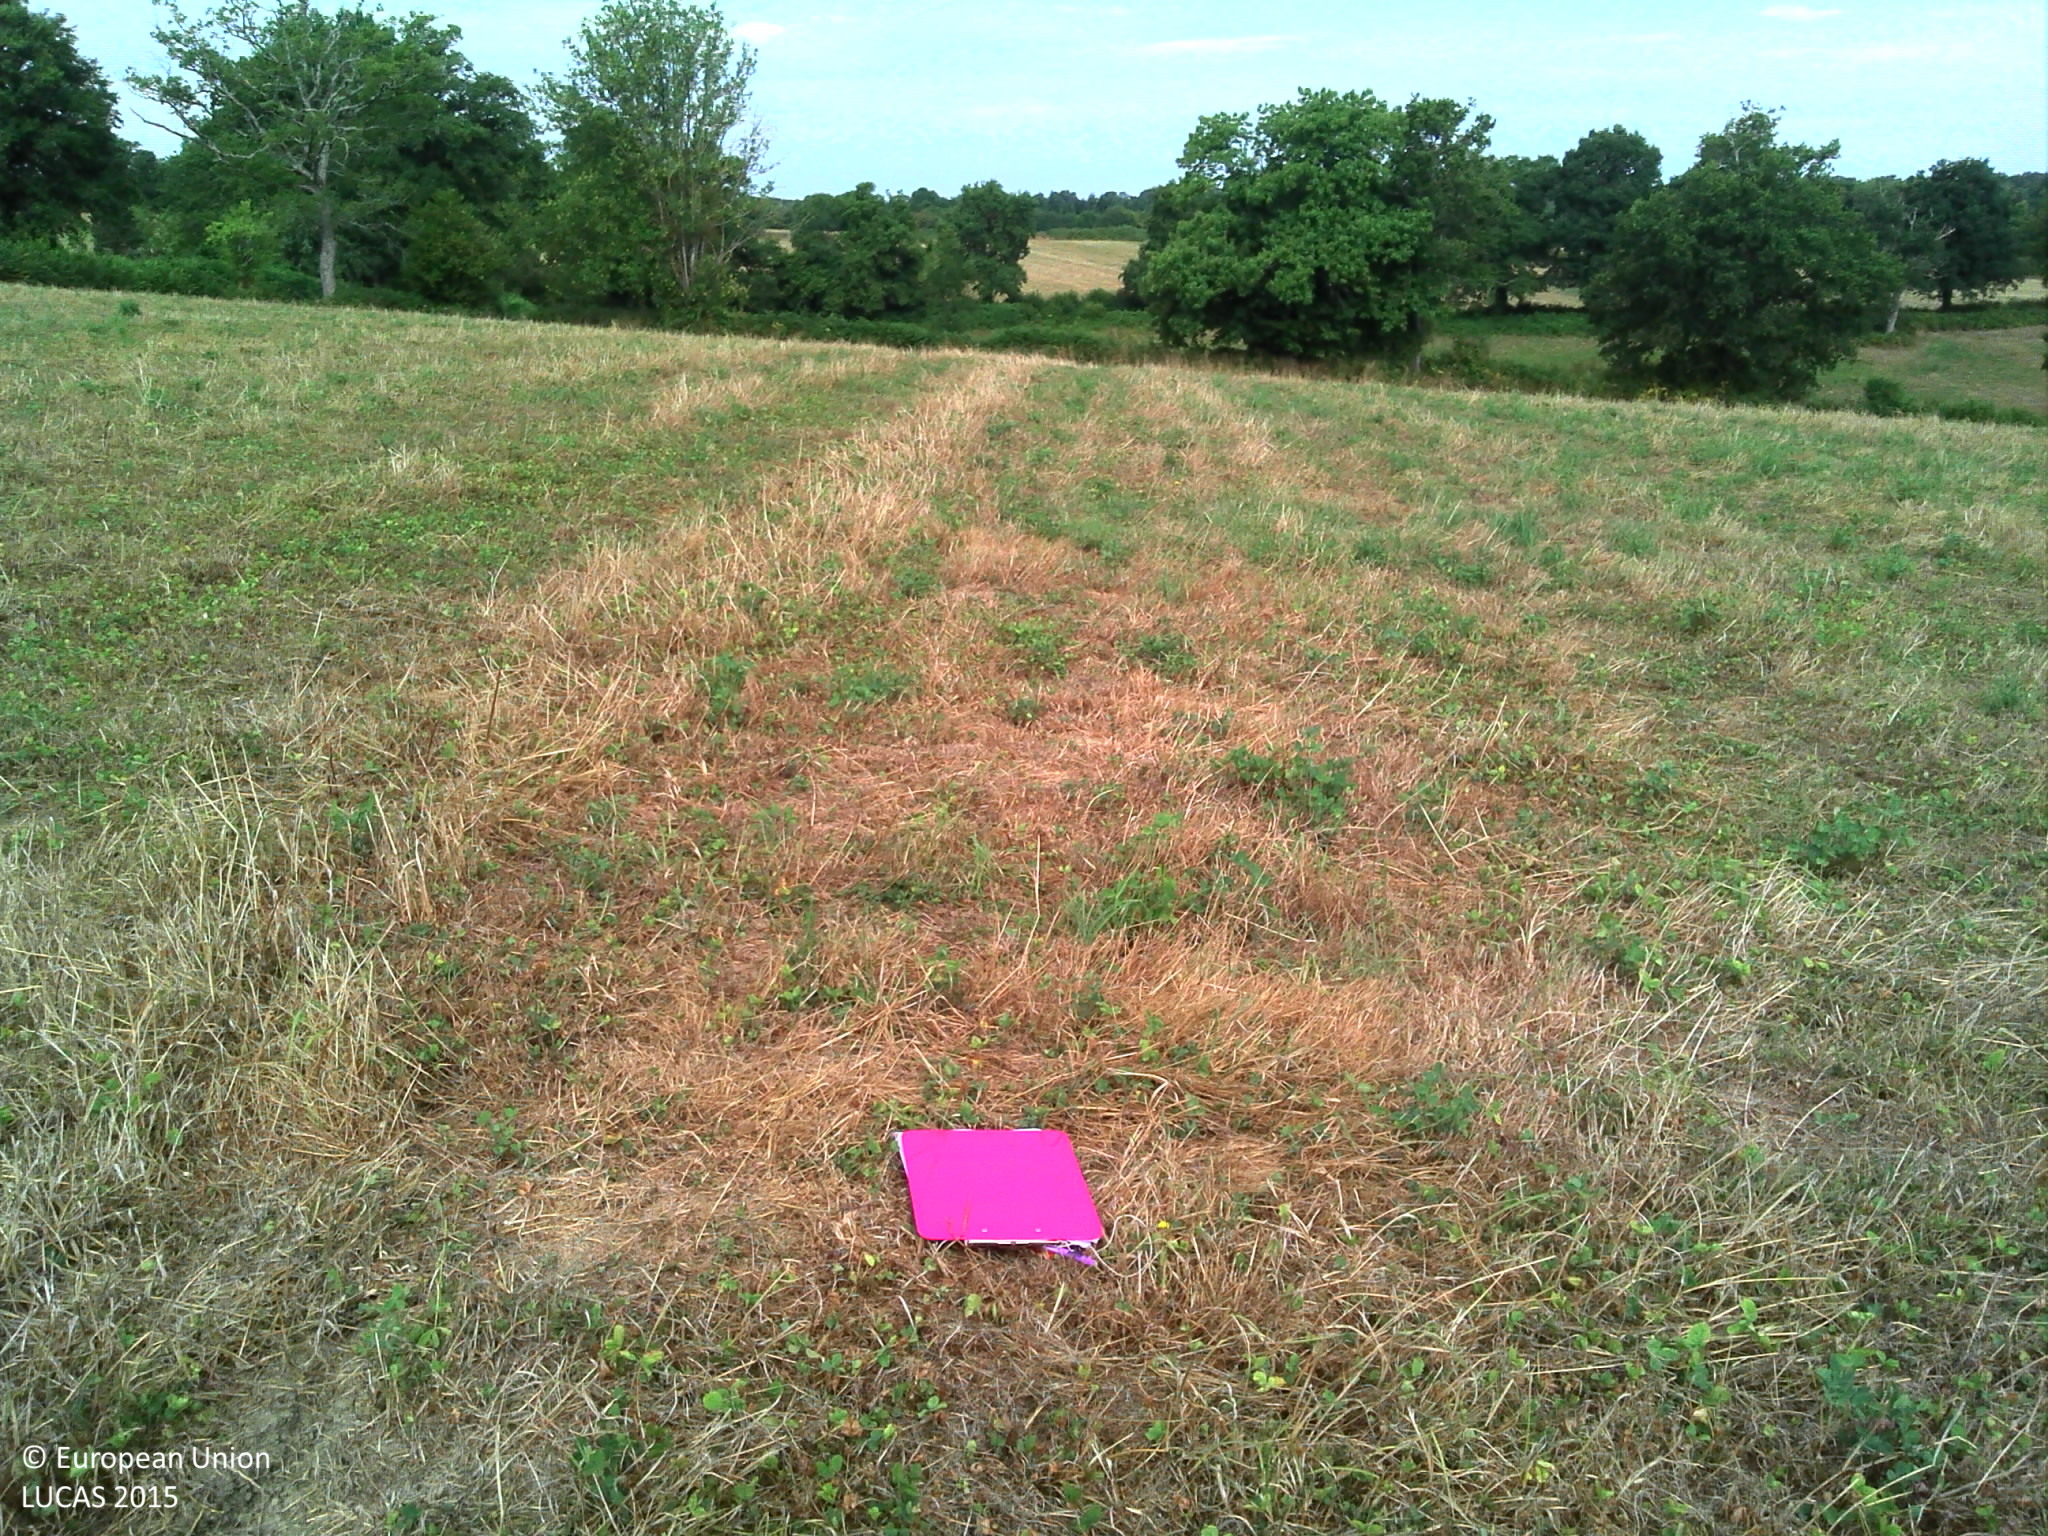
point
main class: Grassland
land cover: Grassland without tree/shrub cover
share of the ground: > 75 %
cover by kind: herbaceous plants 100 %
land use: Agriculture (excluding fallow land and kitchen gardens)
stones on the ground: > 50 %
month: July
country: FR
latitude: 46.2542
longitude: 0.9194
